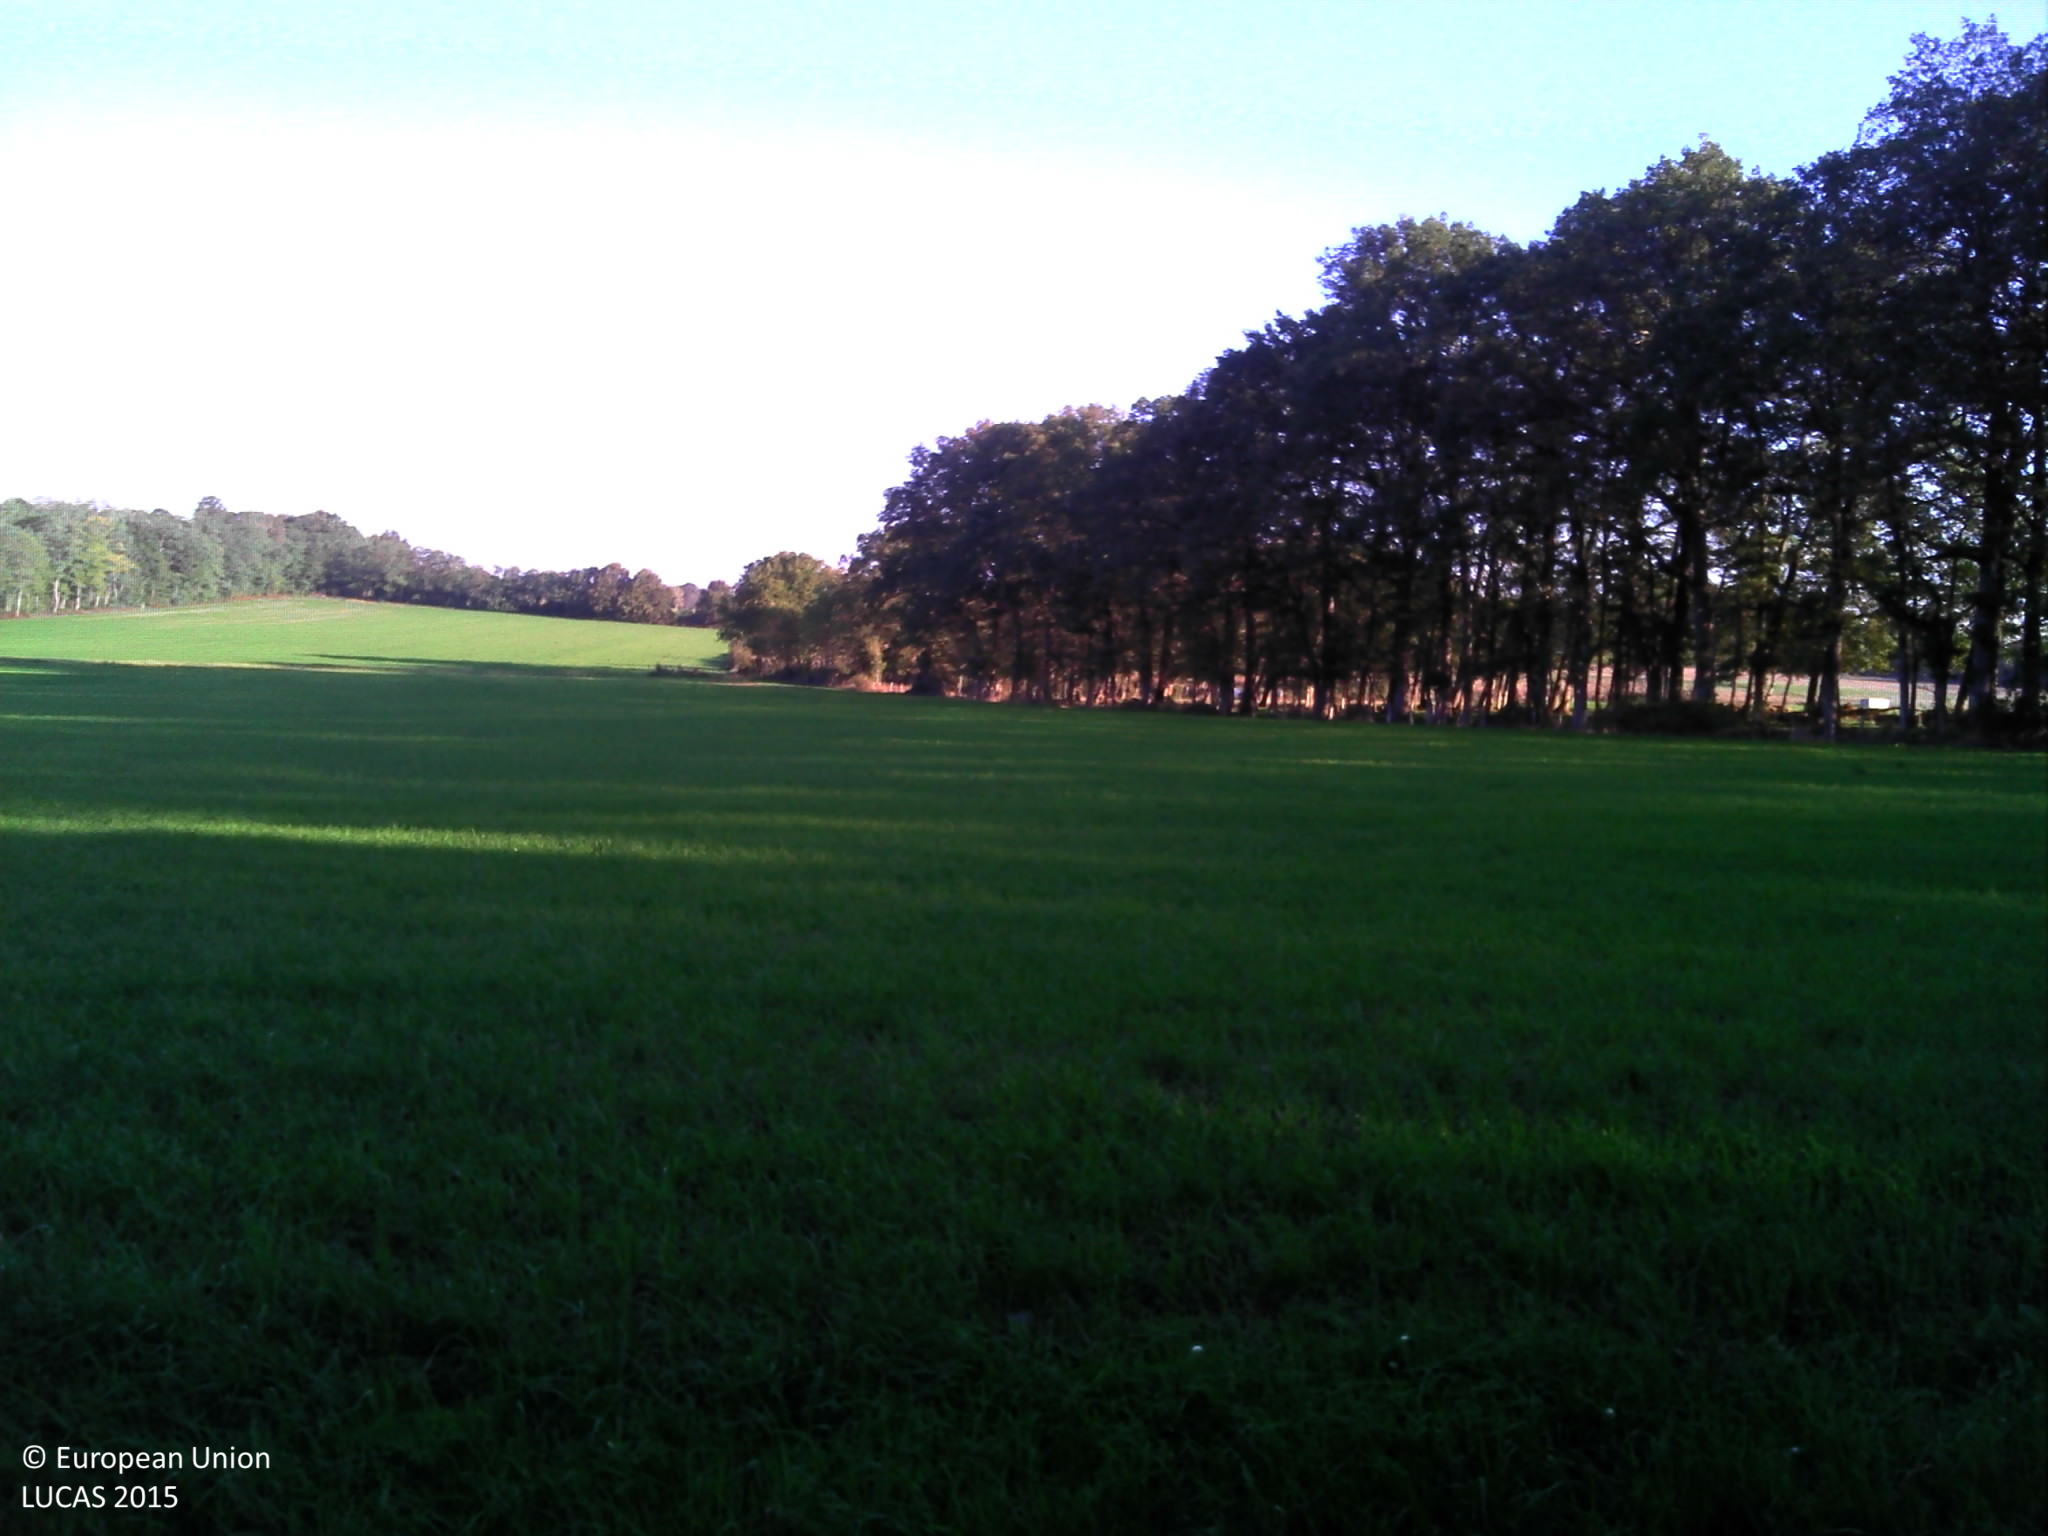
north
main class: Grassland
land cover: Grassland without tree/shrub cover
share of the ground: > 75 %
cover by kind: herbaceous plants 100 %
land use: Agriculture (excluding fallow land and kitchen gardens)
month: October
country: FR
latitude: 48.0362
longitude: 3.8938
